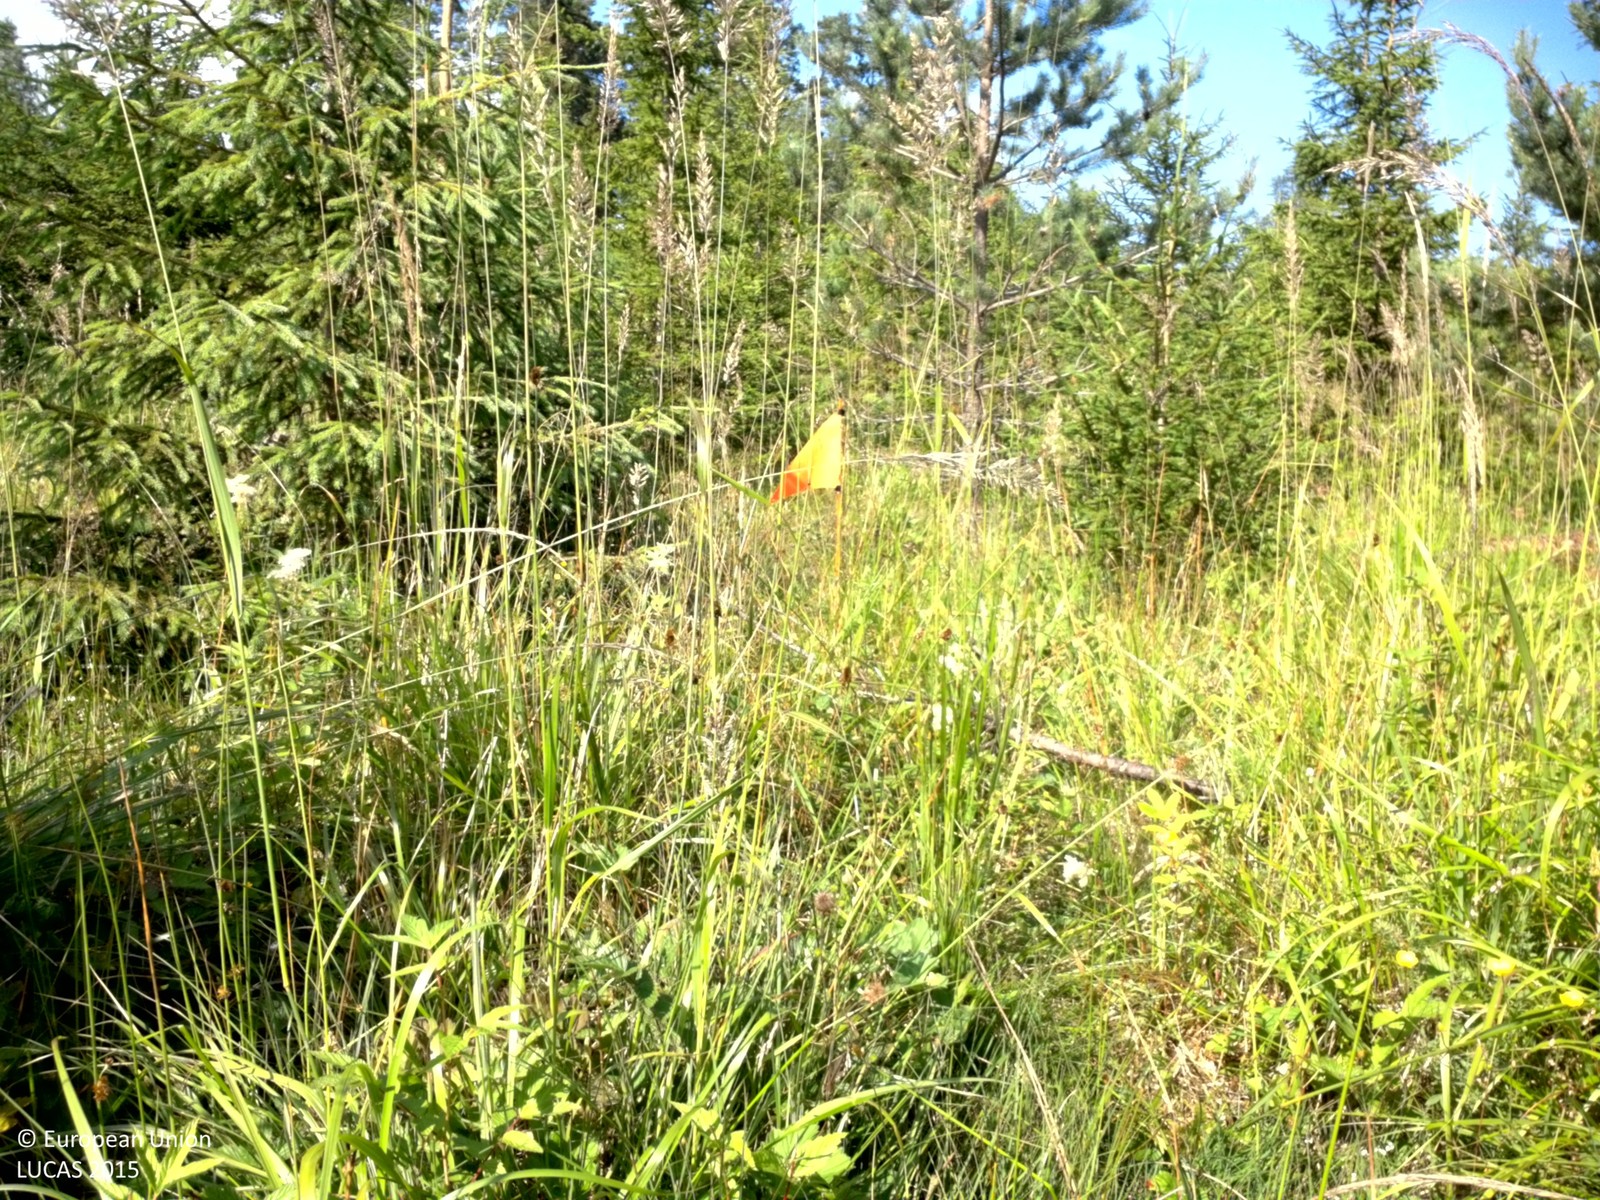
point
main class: Woodland
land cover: Spruce dominated coniferous woodland
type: boreal forest
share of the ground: 25 - 50 %
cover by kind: coniferous forest trees 50 %, herbaceous plants 50 %
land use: Forestry
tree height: < 5 m
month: July
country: SE
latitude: 59.6522
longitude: 18.4989
